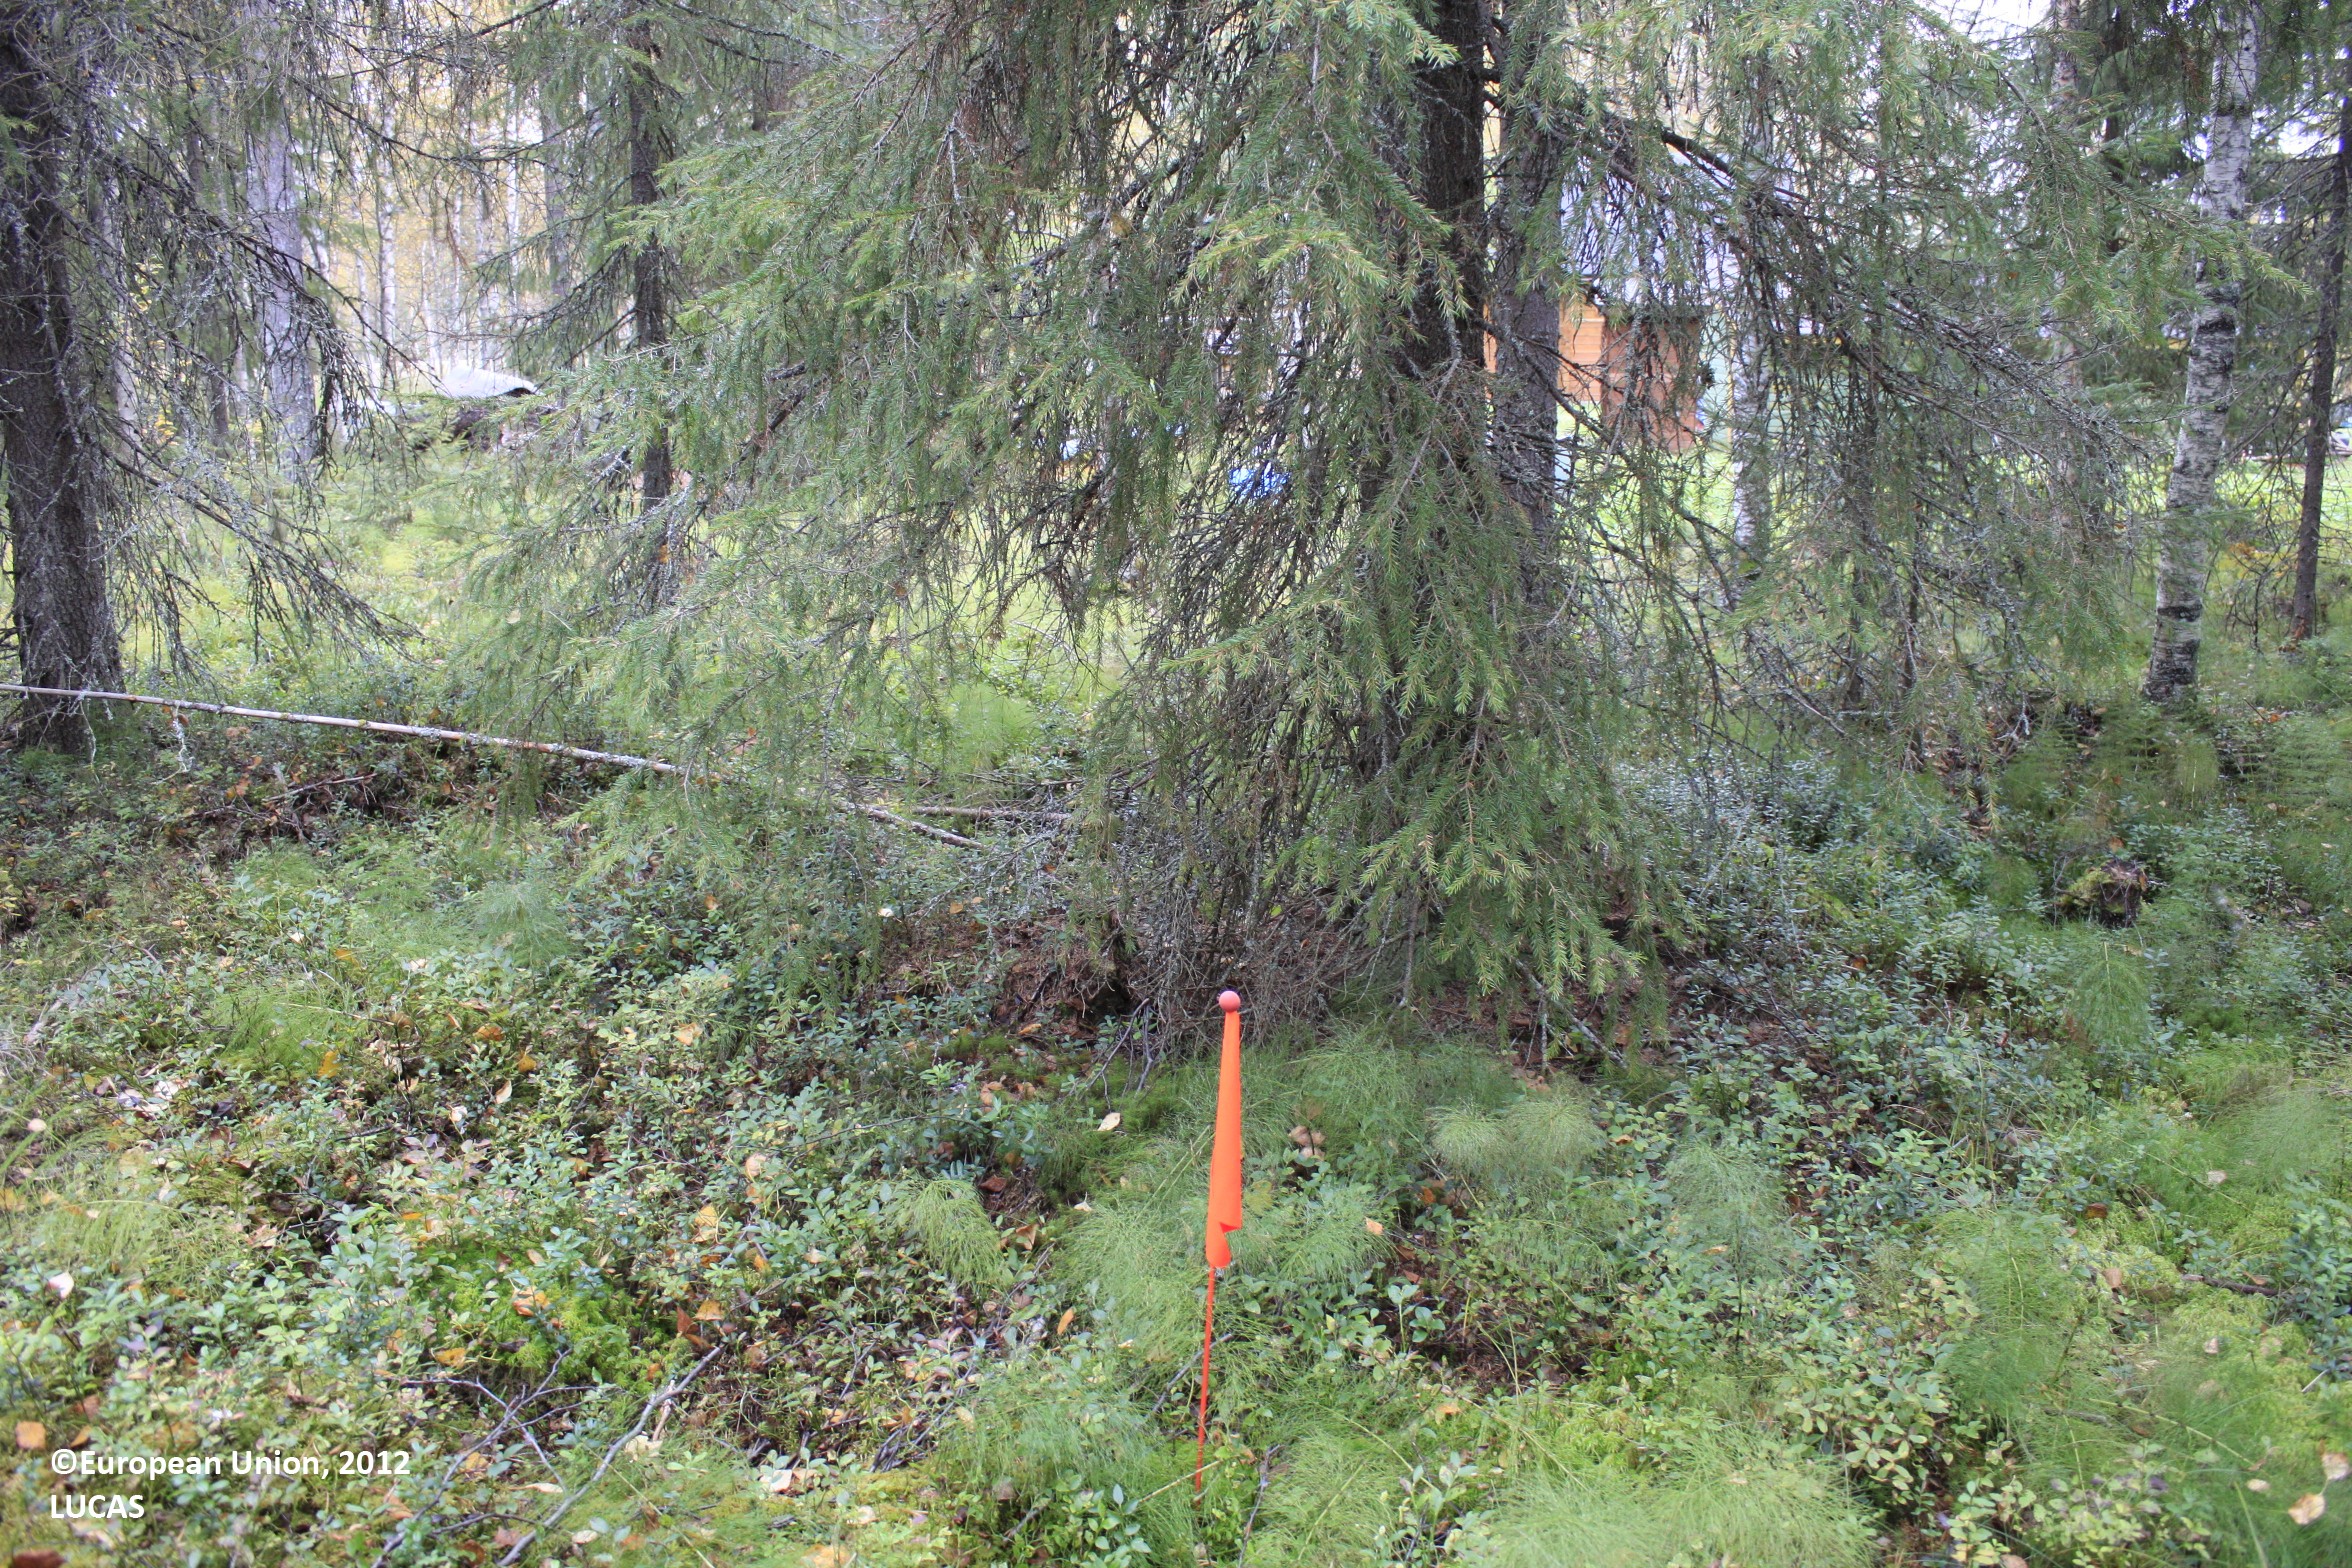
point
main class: Woodland
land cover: Spruce dominated mixed woodland
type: boreal forest
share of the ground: 50 - 75 %
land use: Forestry
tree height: > 5 m
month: September
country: FI
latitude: 65.7018
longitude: 27.3494
